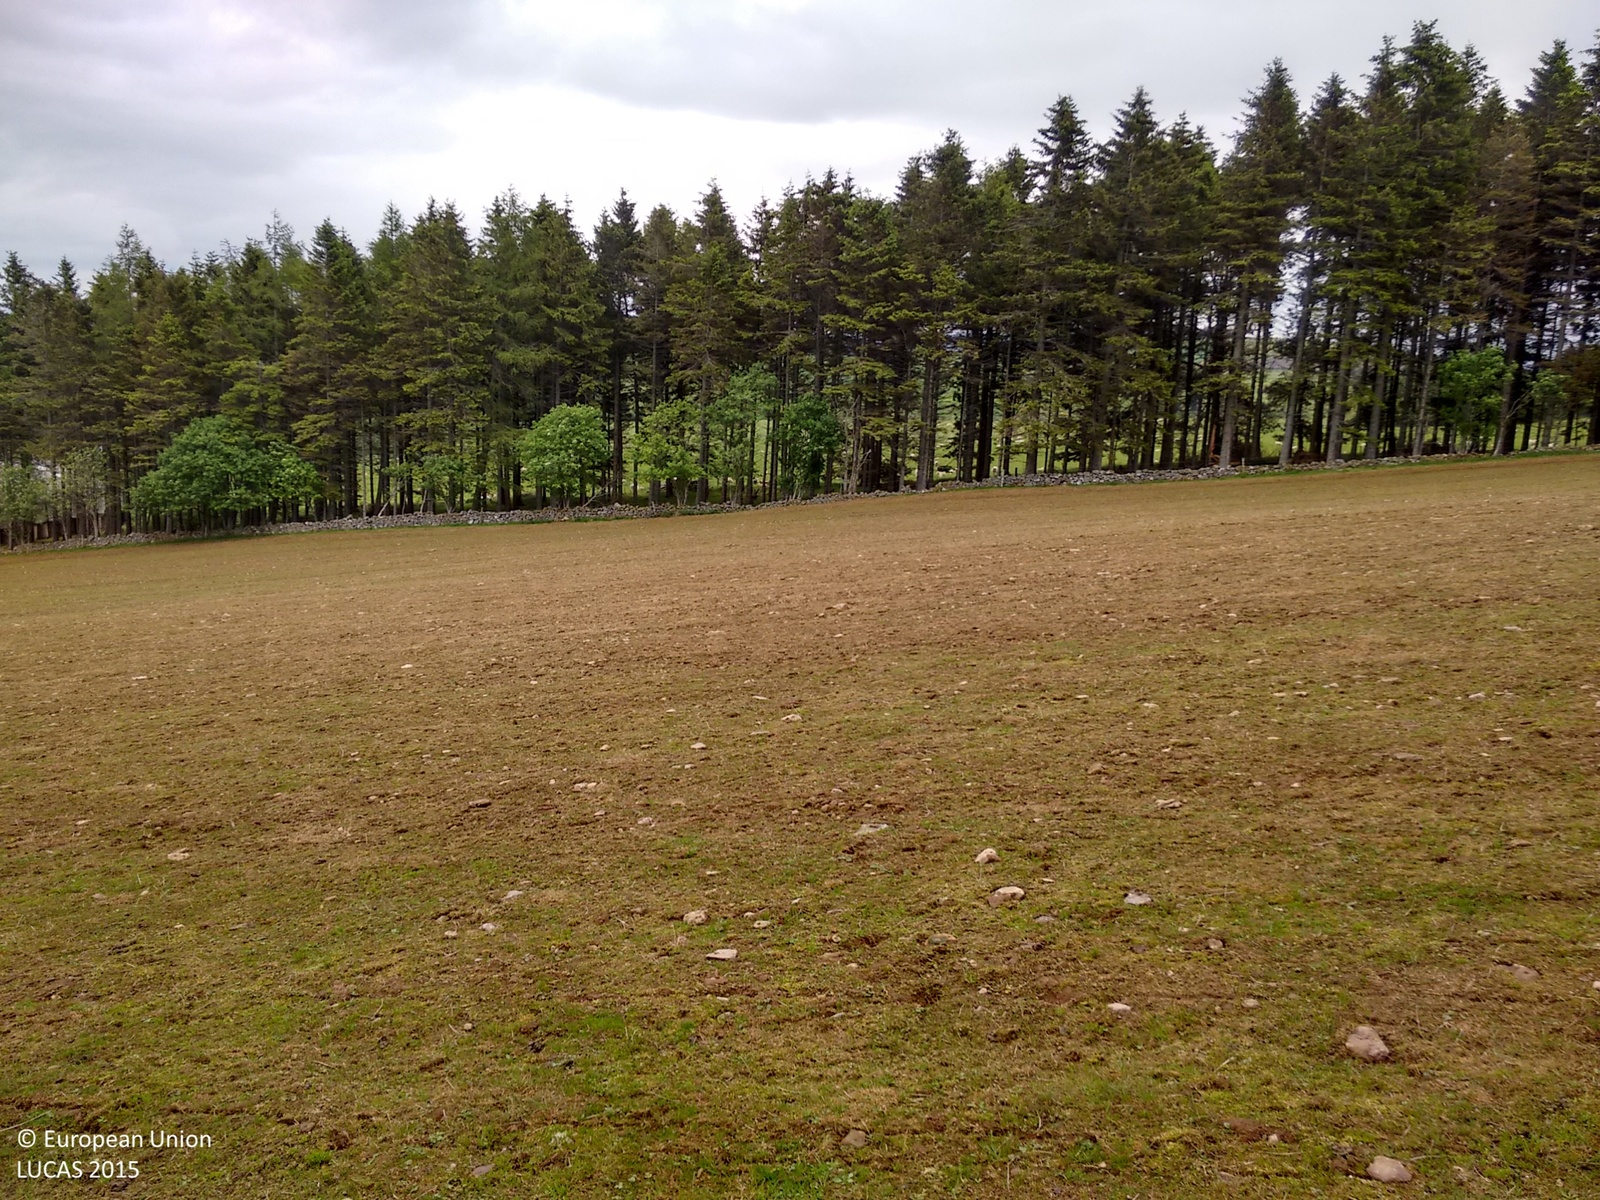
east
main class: Grassland
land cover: Grassland without tree/shrub cover
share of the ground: 25 - 50 %
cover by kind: herbaceous plants 60 %, unconsolidated bare surface 40 %
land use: Agriculture (excluding fallow land and kitchen gardens)
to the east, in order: Grassland without tree/shrub cover; Fences; Dry stone walls; Spruce dominated coniferous woodland; Dry stone walls; Grass margins; Fences; Grassland without tree/shrub cover
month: June
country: GB
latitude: 57.1831
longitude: -2.8150
